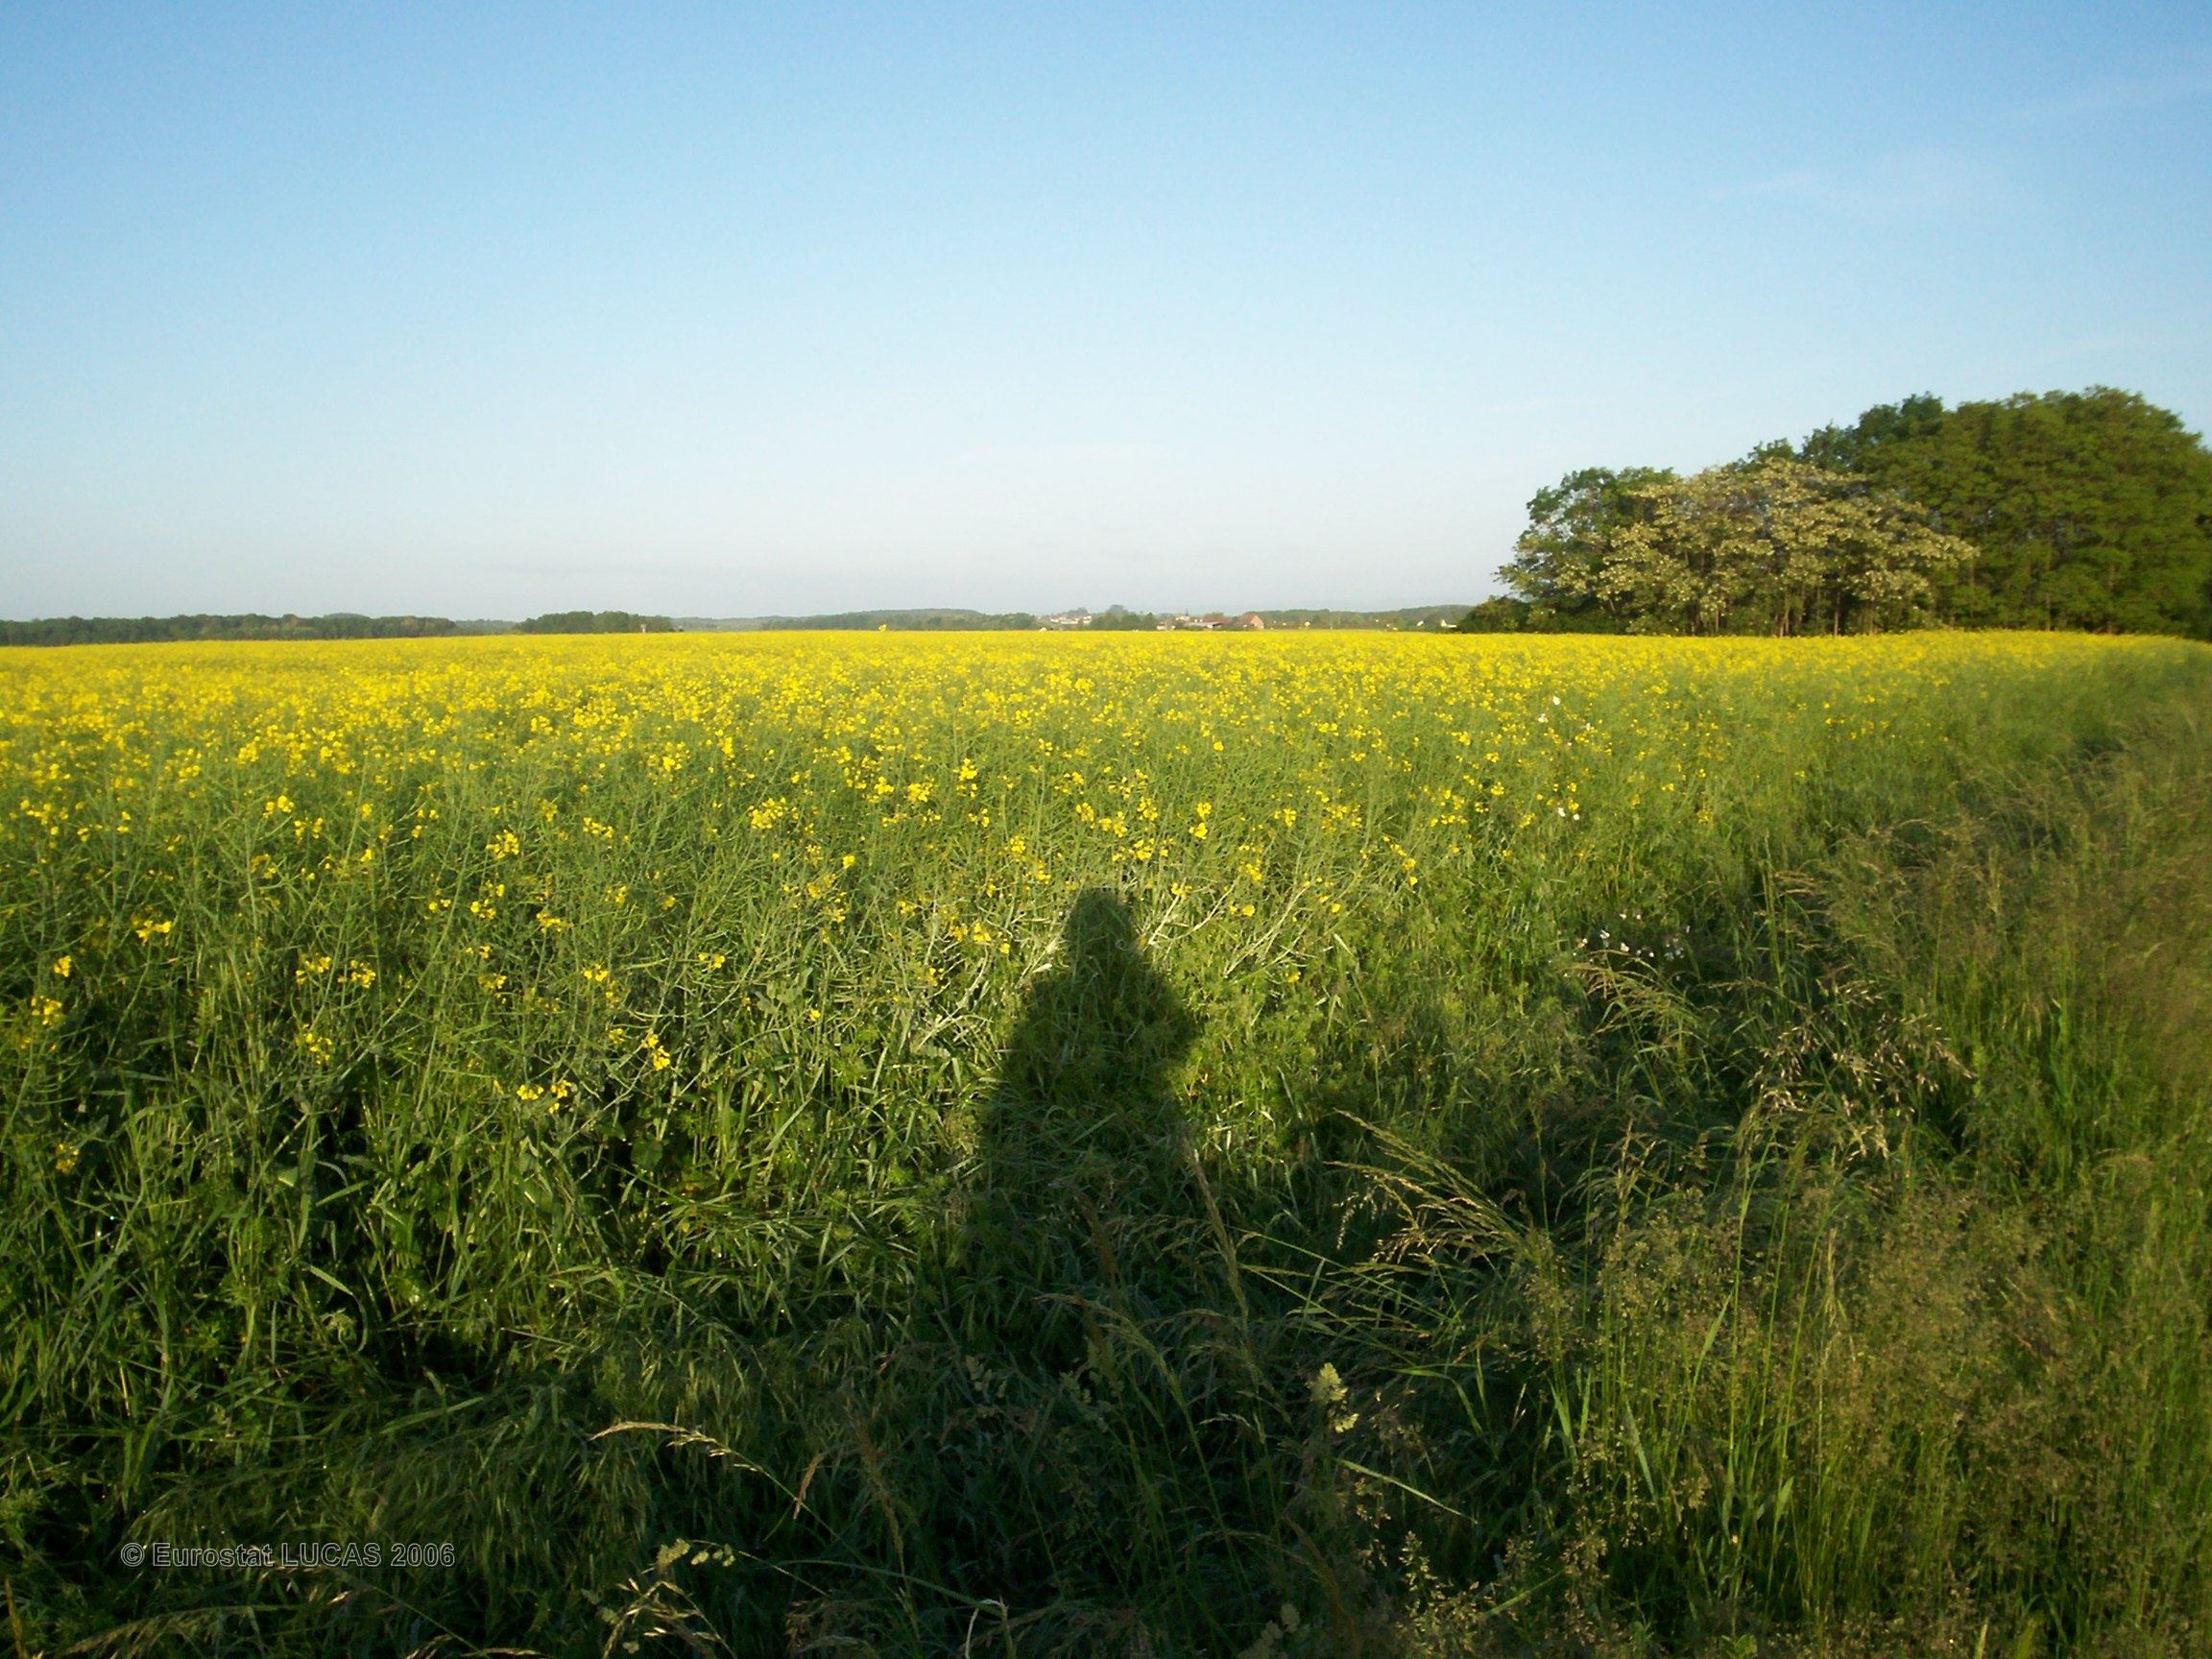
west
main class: Cropland
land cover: Rape and turnip rape
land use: Agriculture (excluding fallow land and kitchen gardens)
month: May
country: FR
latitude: 47.3494
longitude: 5.3280
